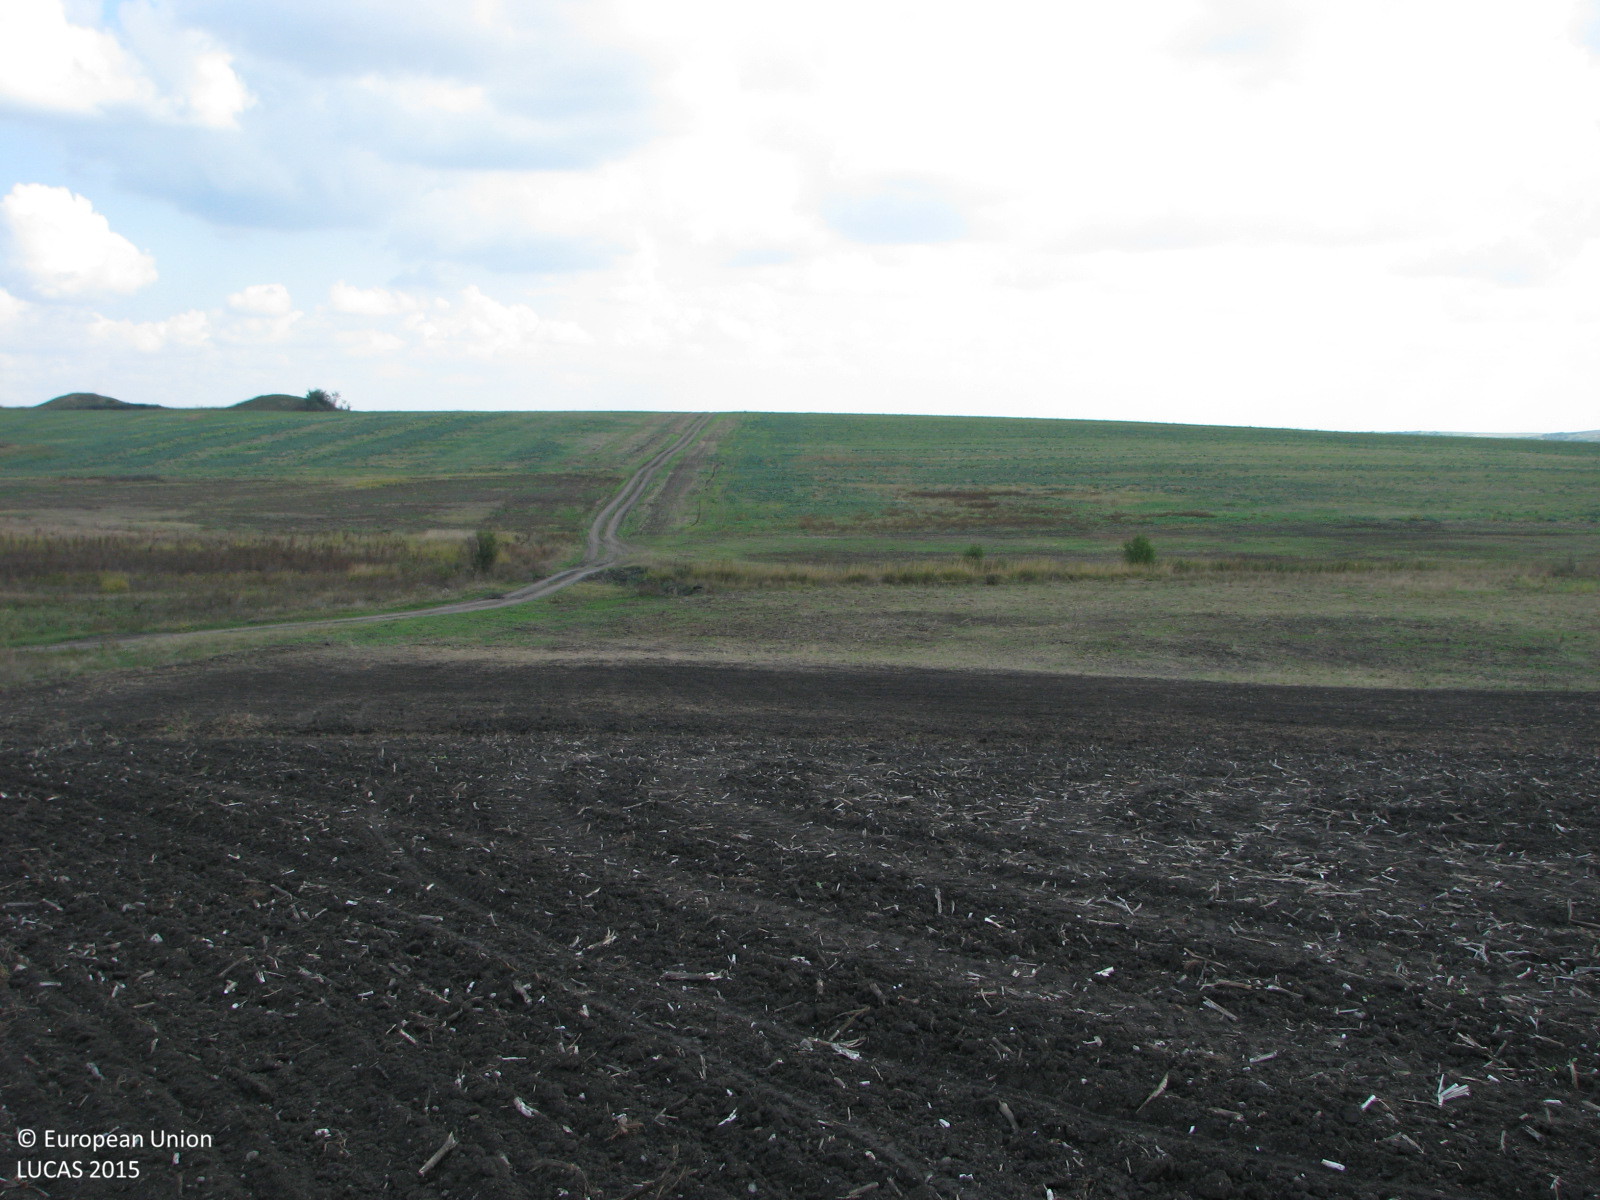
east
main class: Cropland
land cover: Sunflower
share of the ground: < 10 %
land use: Agriculture (excluding fallow land and kitchen gardens)
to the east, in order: Sunflower; Grassland without tree/shrub cover; Ditches and canals; Grassland without tree/shrub cover; Sunflower
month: October
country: BG
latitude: 42.2934
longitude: 26.3259
